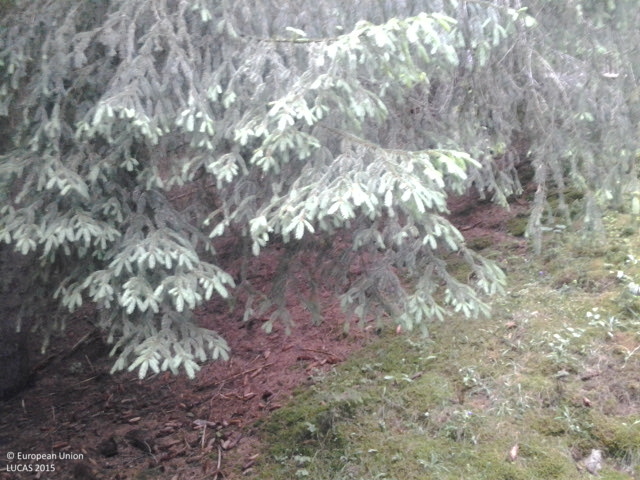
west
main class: Woodland
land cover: Spruce dominated coniferous woodland
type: alpine coniferous forest
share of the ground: > 75 %
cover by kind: coniferous forest trees 100 %
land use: Forestry
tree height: > 5 m
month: June
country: RO
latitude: 47.3034
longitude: 25.3610
